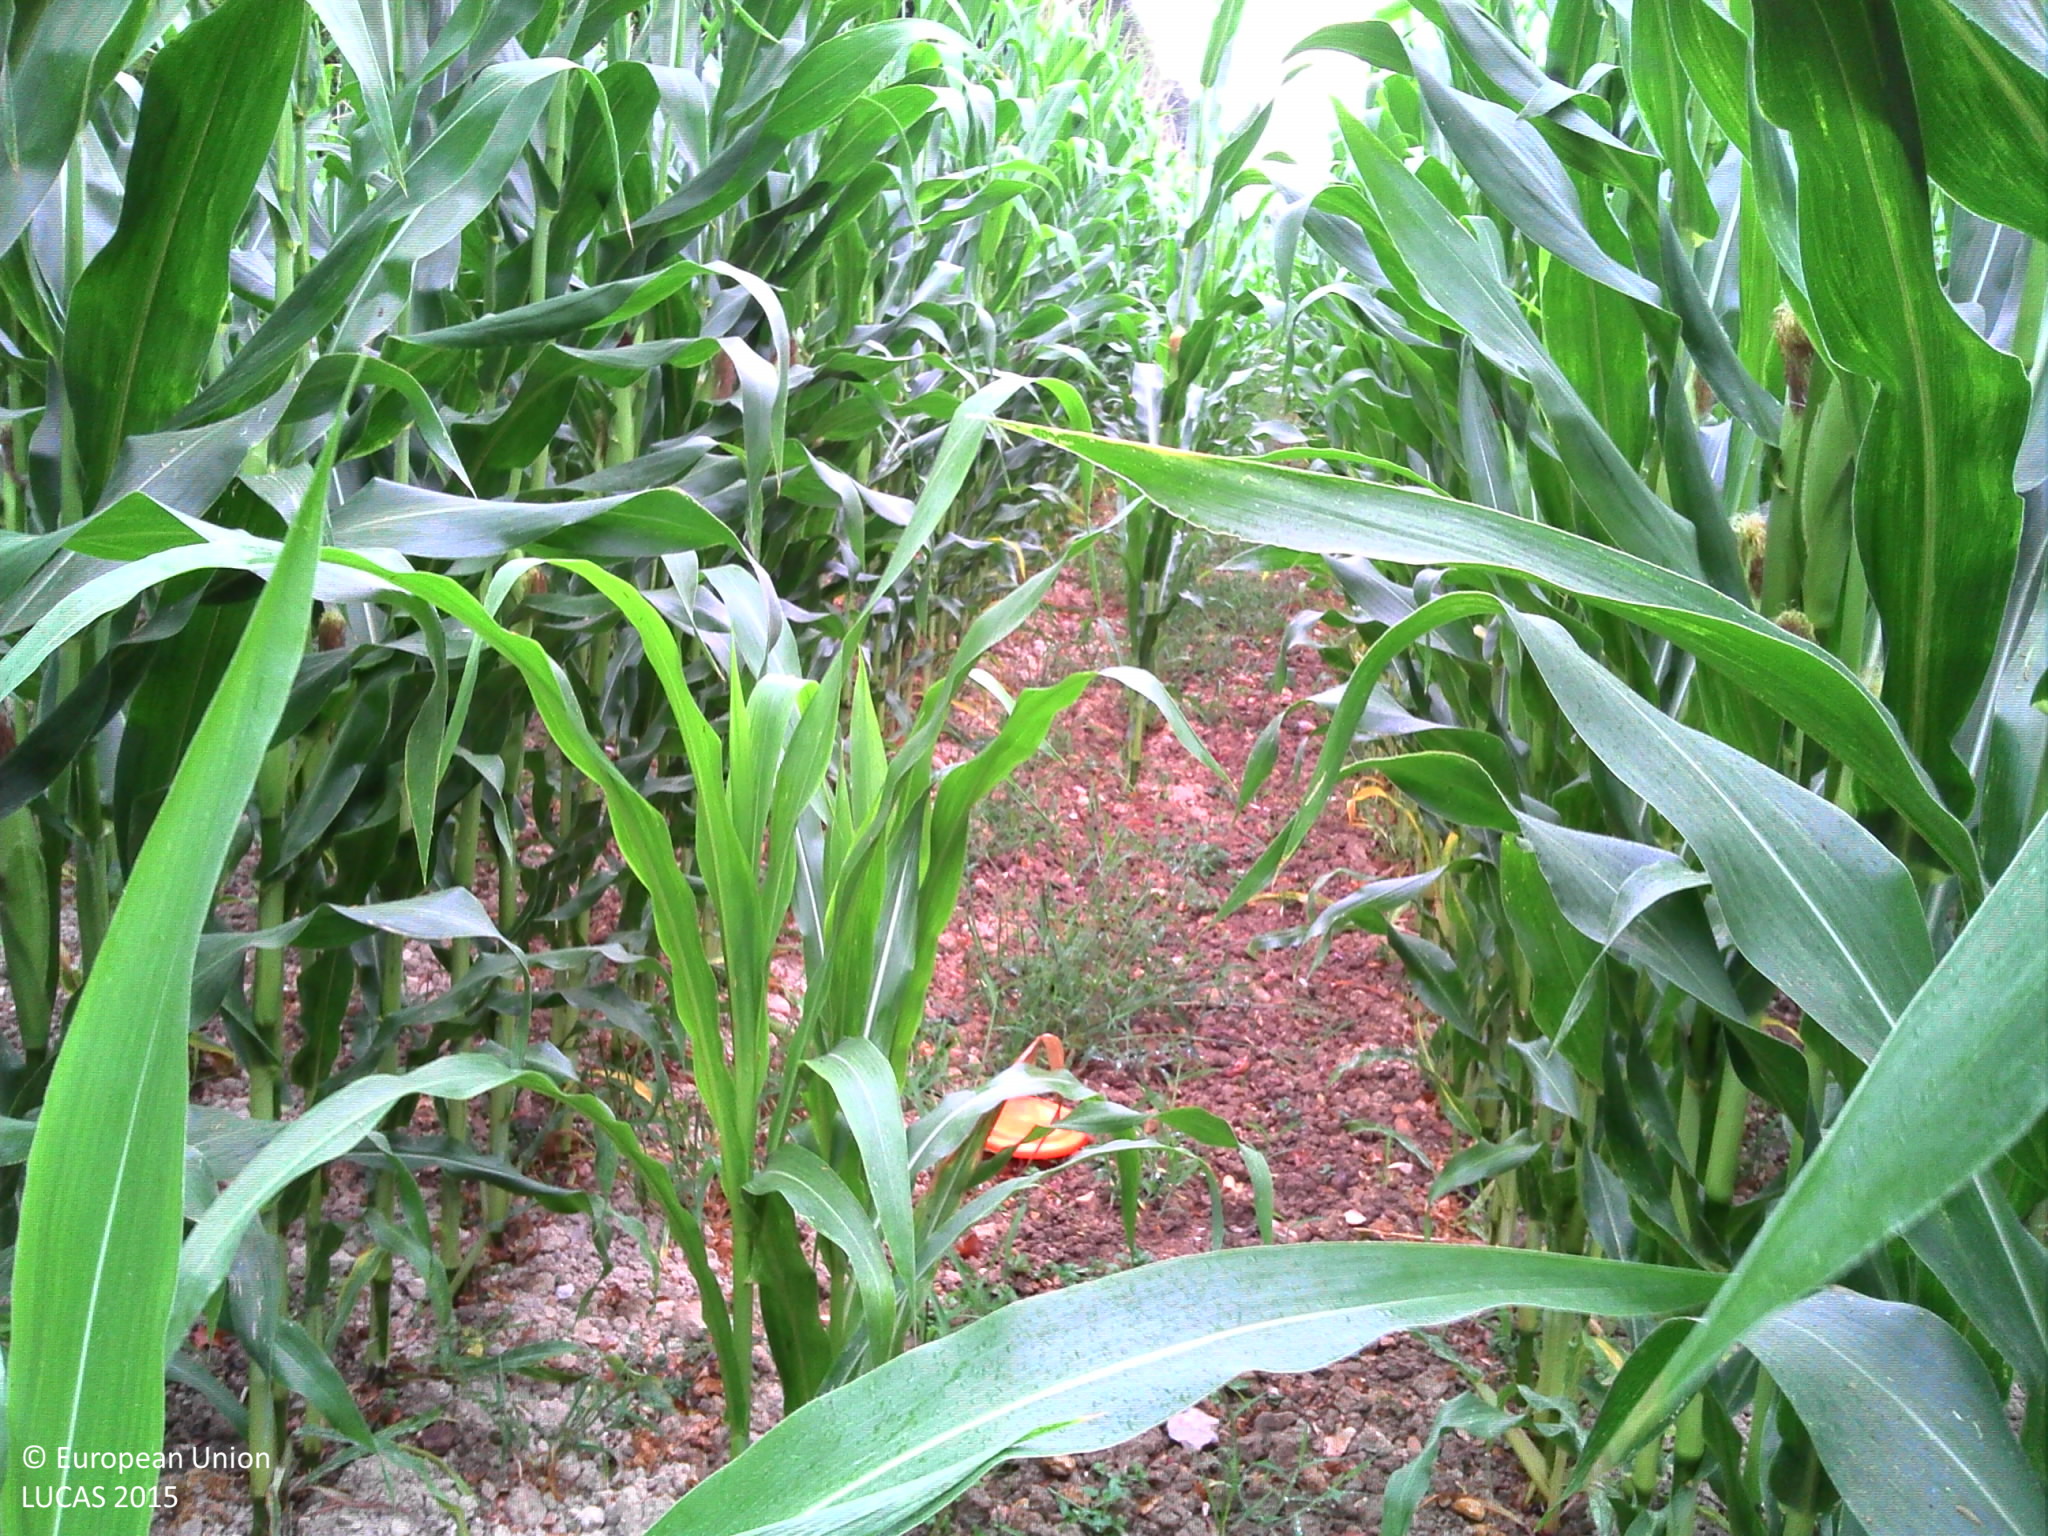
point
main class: Cropland
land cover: Maize
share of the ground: > 75 %
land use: Agriculture (excluding fallow land and kitchen gardens)
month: August
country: FR
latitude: 47.6289
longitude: 3.1143
